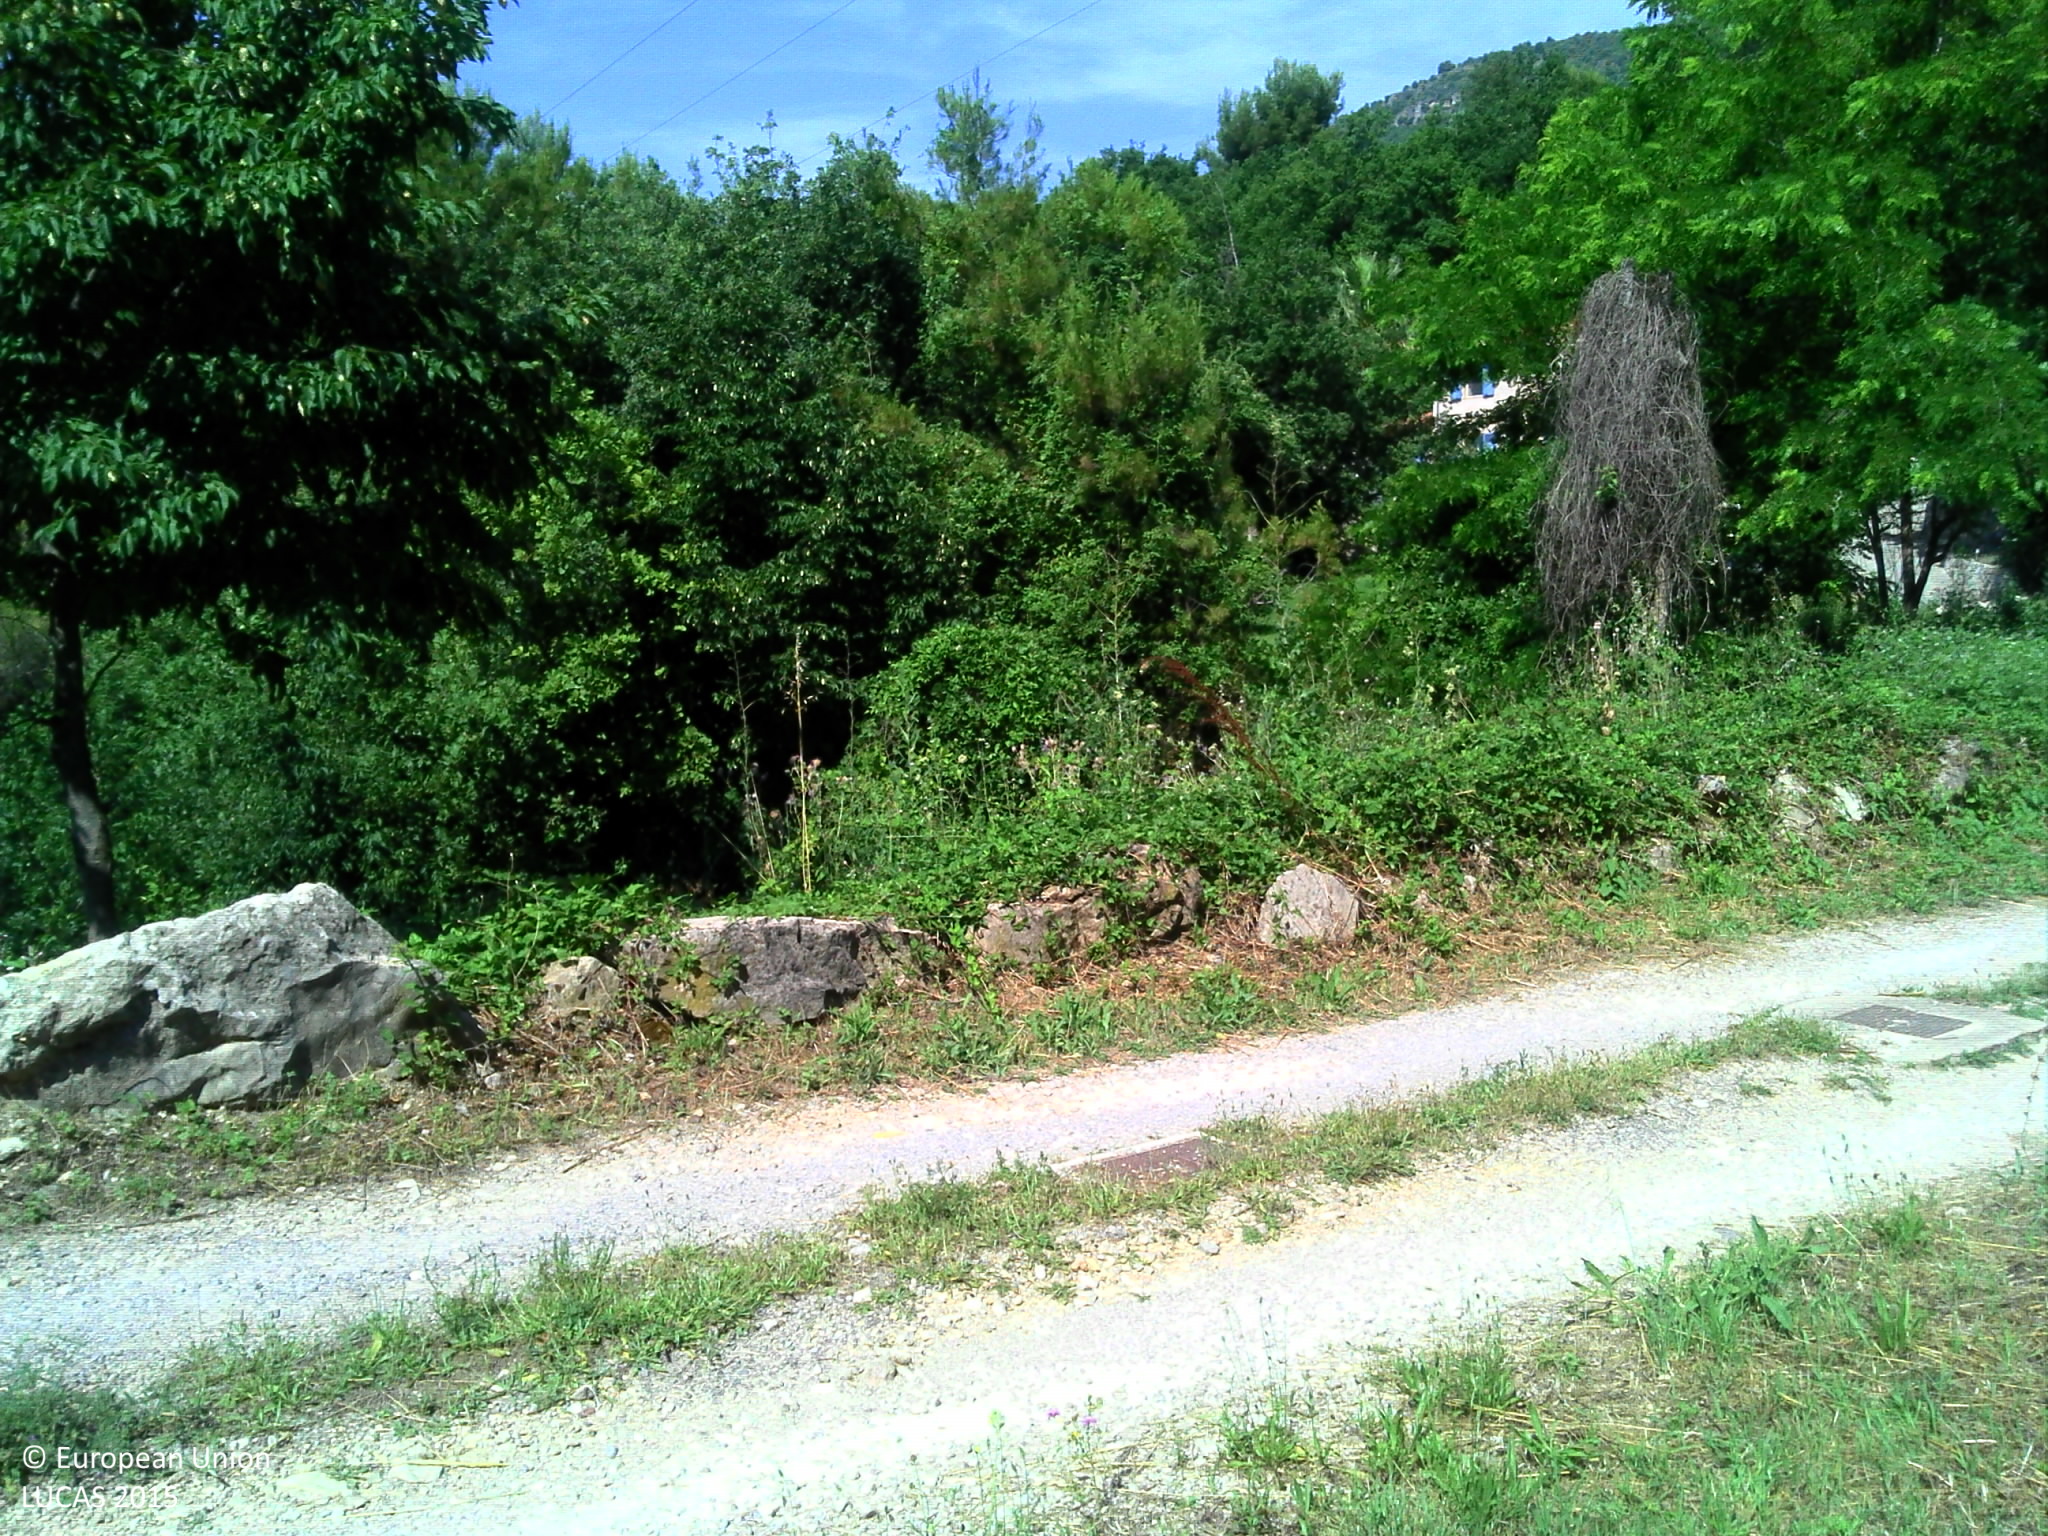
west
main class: Grassland
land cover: Spontaneously vegetated surfaces
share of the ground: > 75 %
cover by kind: herbaceous plants 80 %, consolidated bare surface 15 %, shrubs 5 %
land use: Semi-natural and natural areas not in use
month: June
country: FR
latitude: 43.7134
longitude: 7.0656
